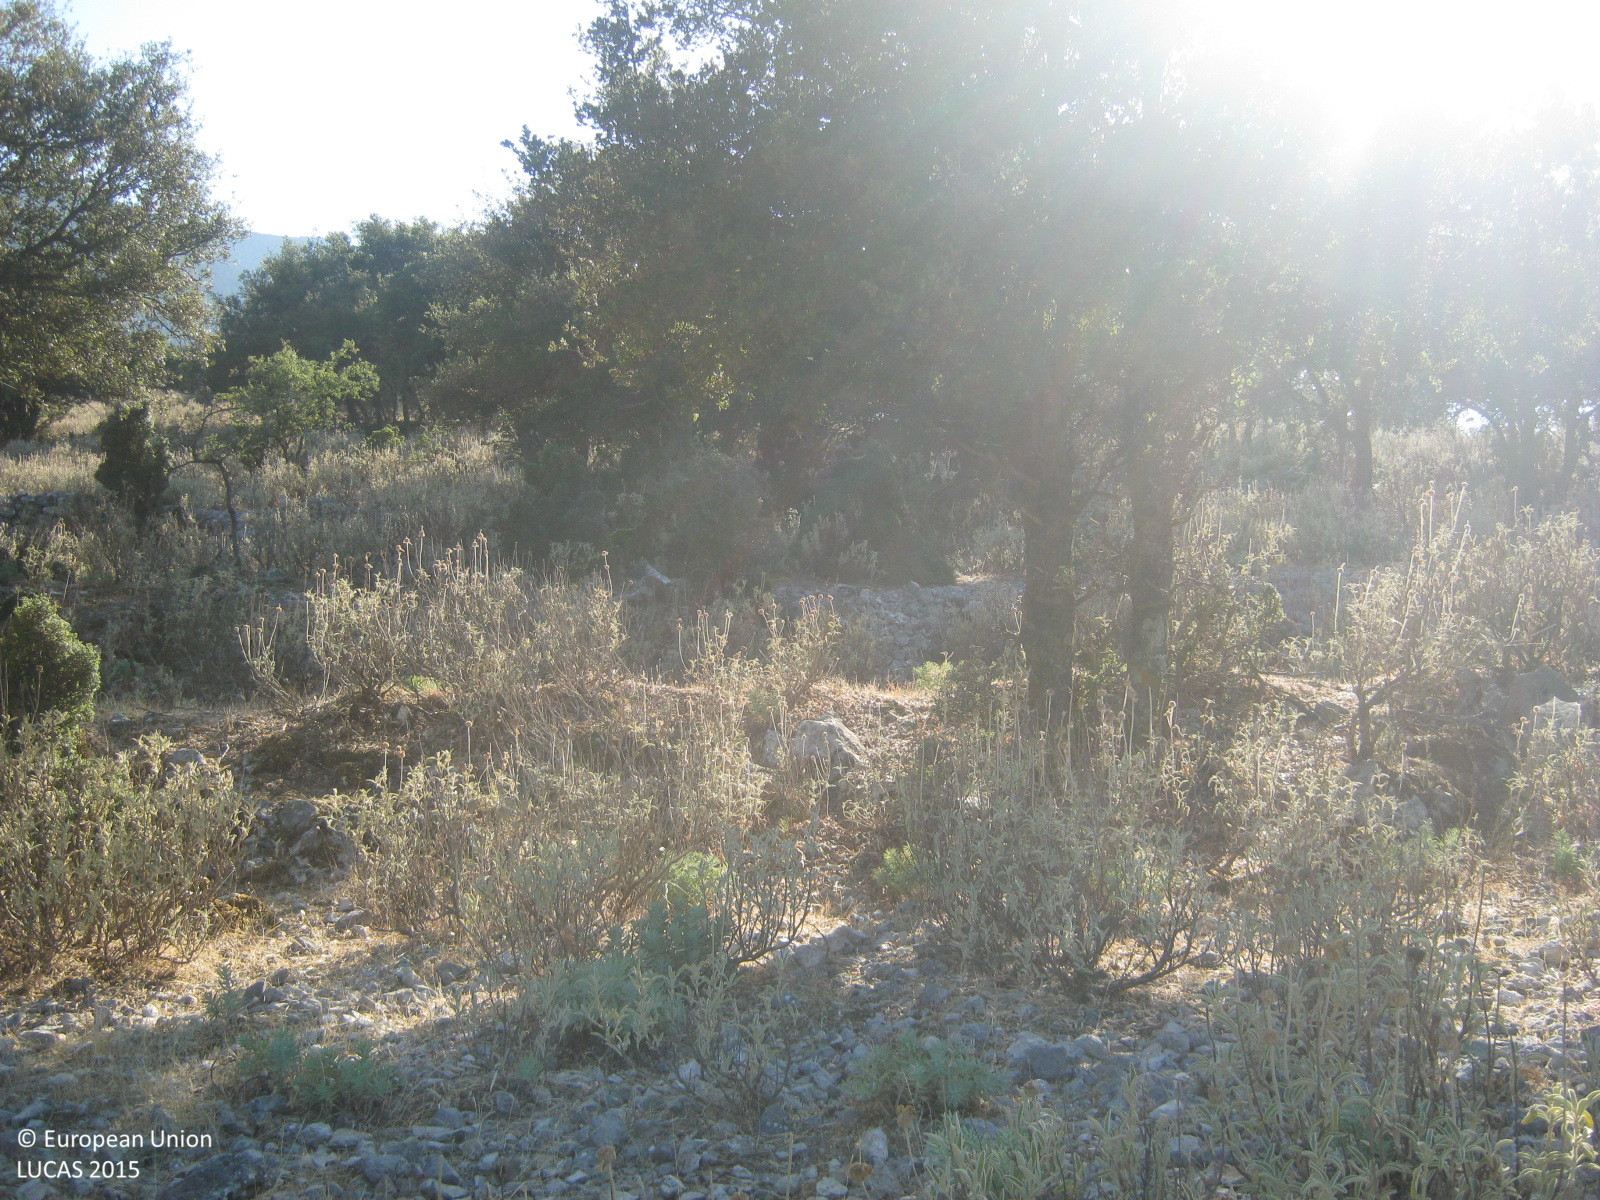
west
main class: Grassland
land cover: Grassland with sparse tree/shrub cover
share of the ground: > 75 %
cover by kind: herbaceous plants 75 %, shrubs 10 %, consolidated bare surface 10 %, broadleaved forest trees 5 %
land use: Semi-natural and natural areas not in use
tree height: < 5 m
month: July
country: GR
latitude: 38.1678
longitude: 20.6791
